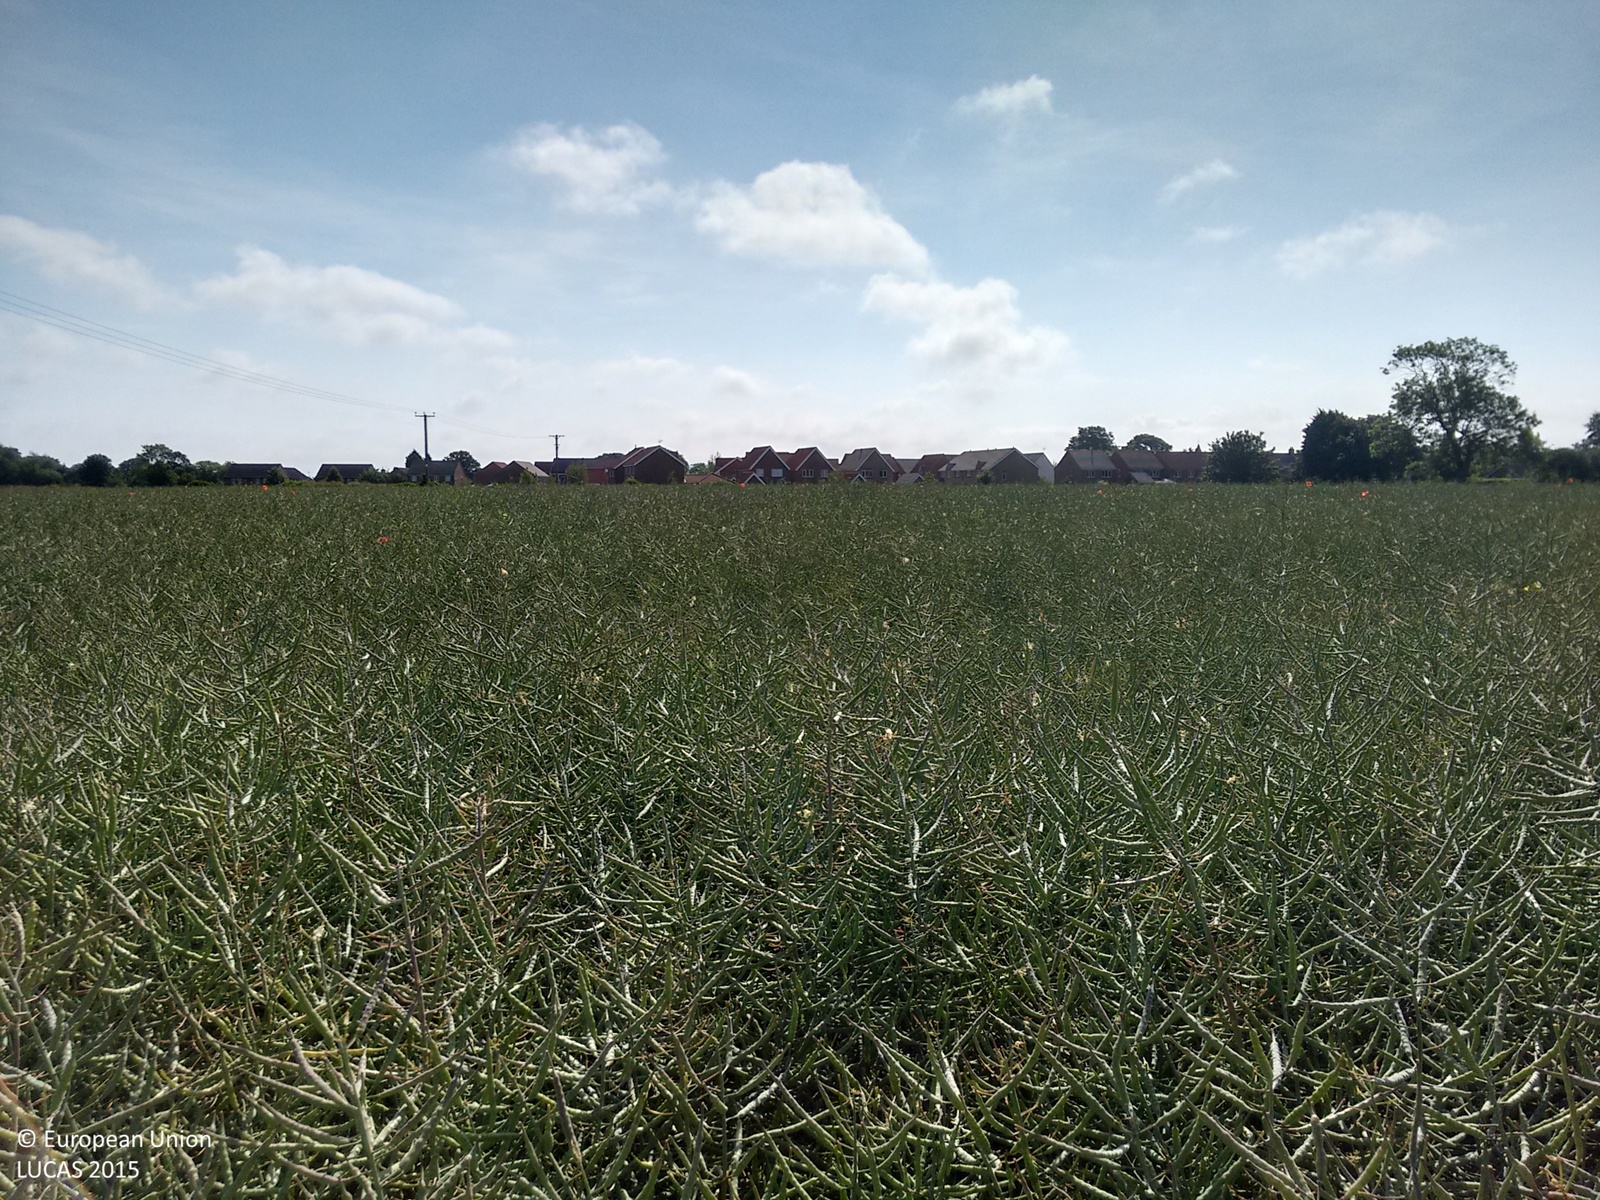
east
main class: Cropland
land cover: Rape and turnip rape
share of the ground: > 75 %
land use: Agriculture (excluding fallow land and kitchen gardens)
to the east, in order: Rape and turnip rape; Grass margins; Managed hedges; Grass margins; Common wheat; Grass margins; Artificial constructions in urban areas
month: June
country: GB
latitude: 53.7733
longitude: -1.1672
